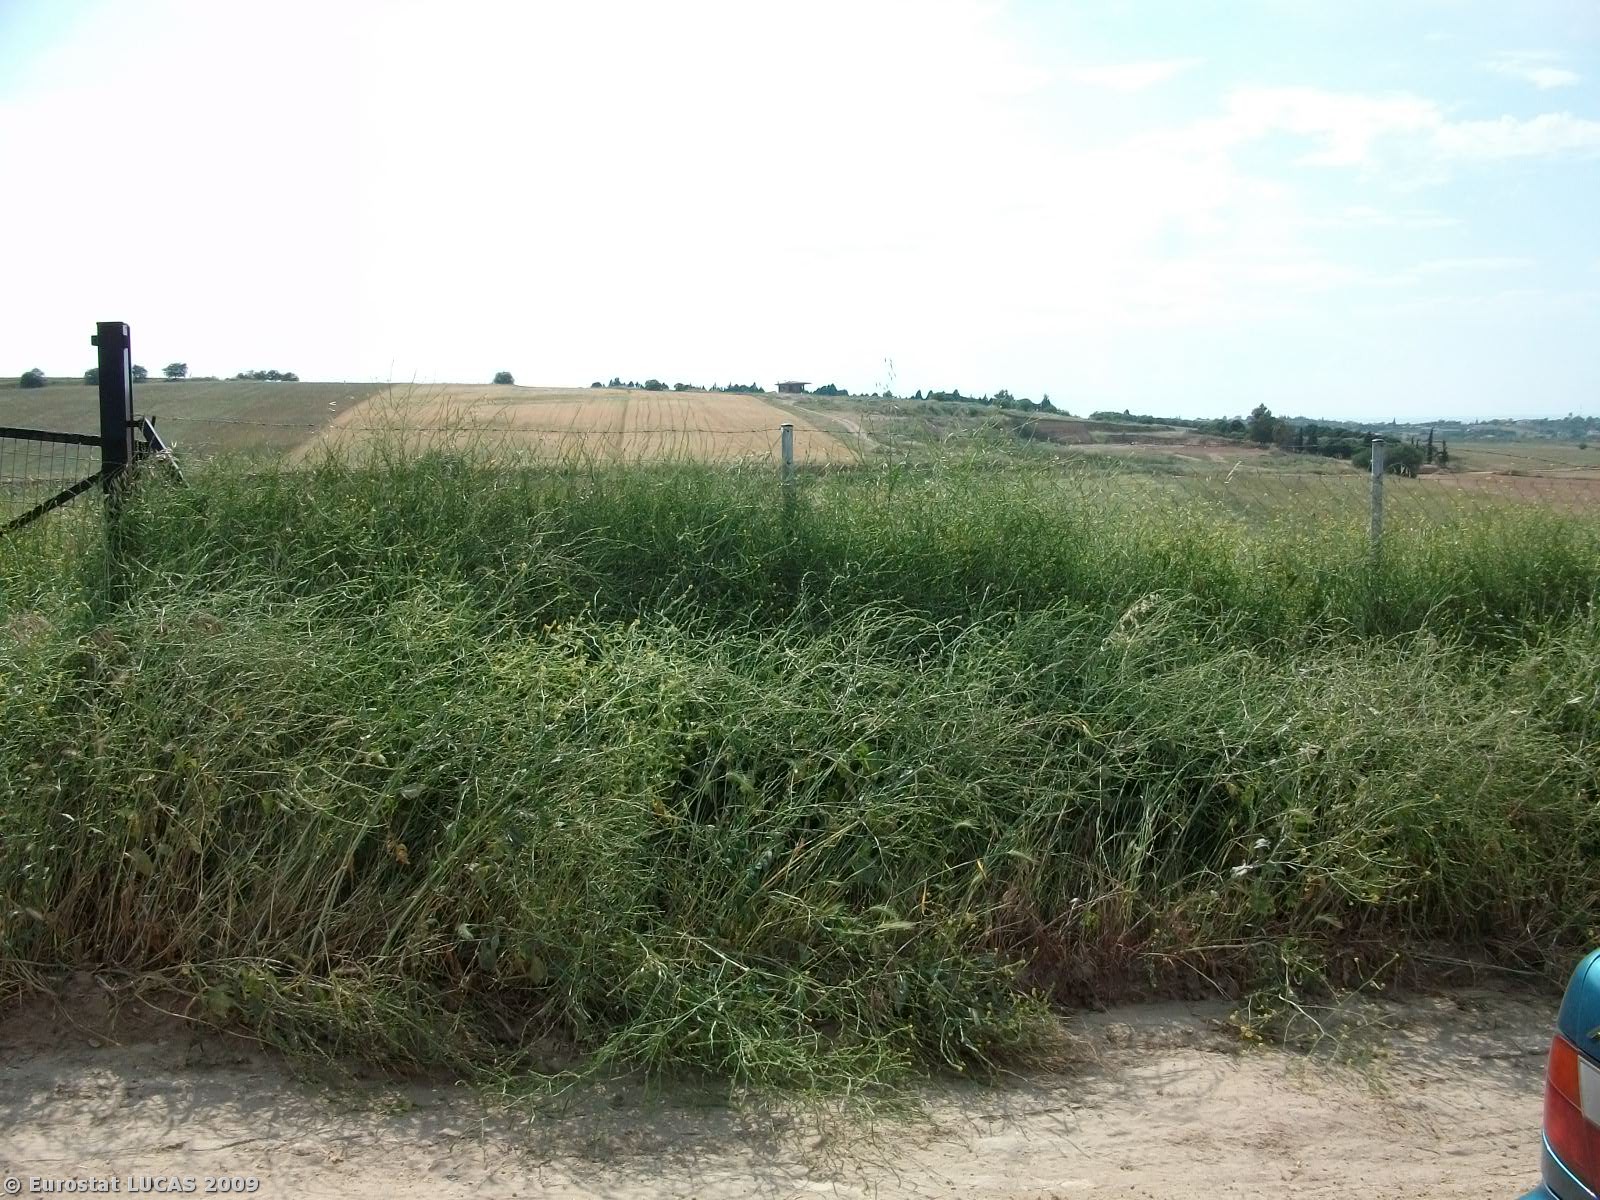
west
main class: Cropland
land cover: Common wheat
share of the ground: > 75 %
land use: Agriculture (excluding fallow land and kitchen gardens)
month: May
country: GR
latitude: 40.4849
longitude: 22.9469
